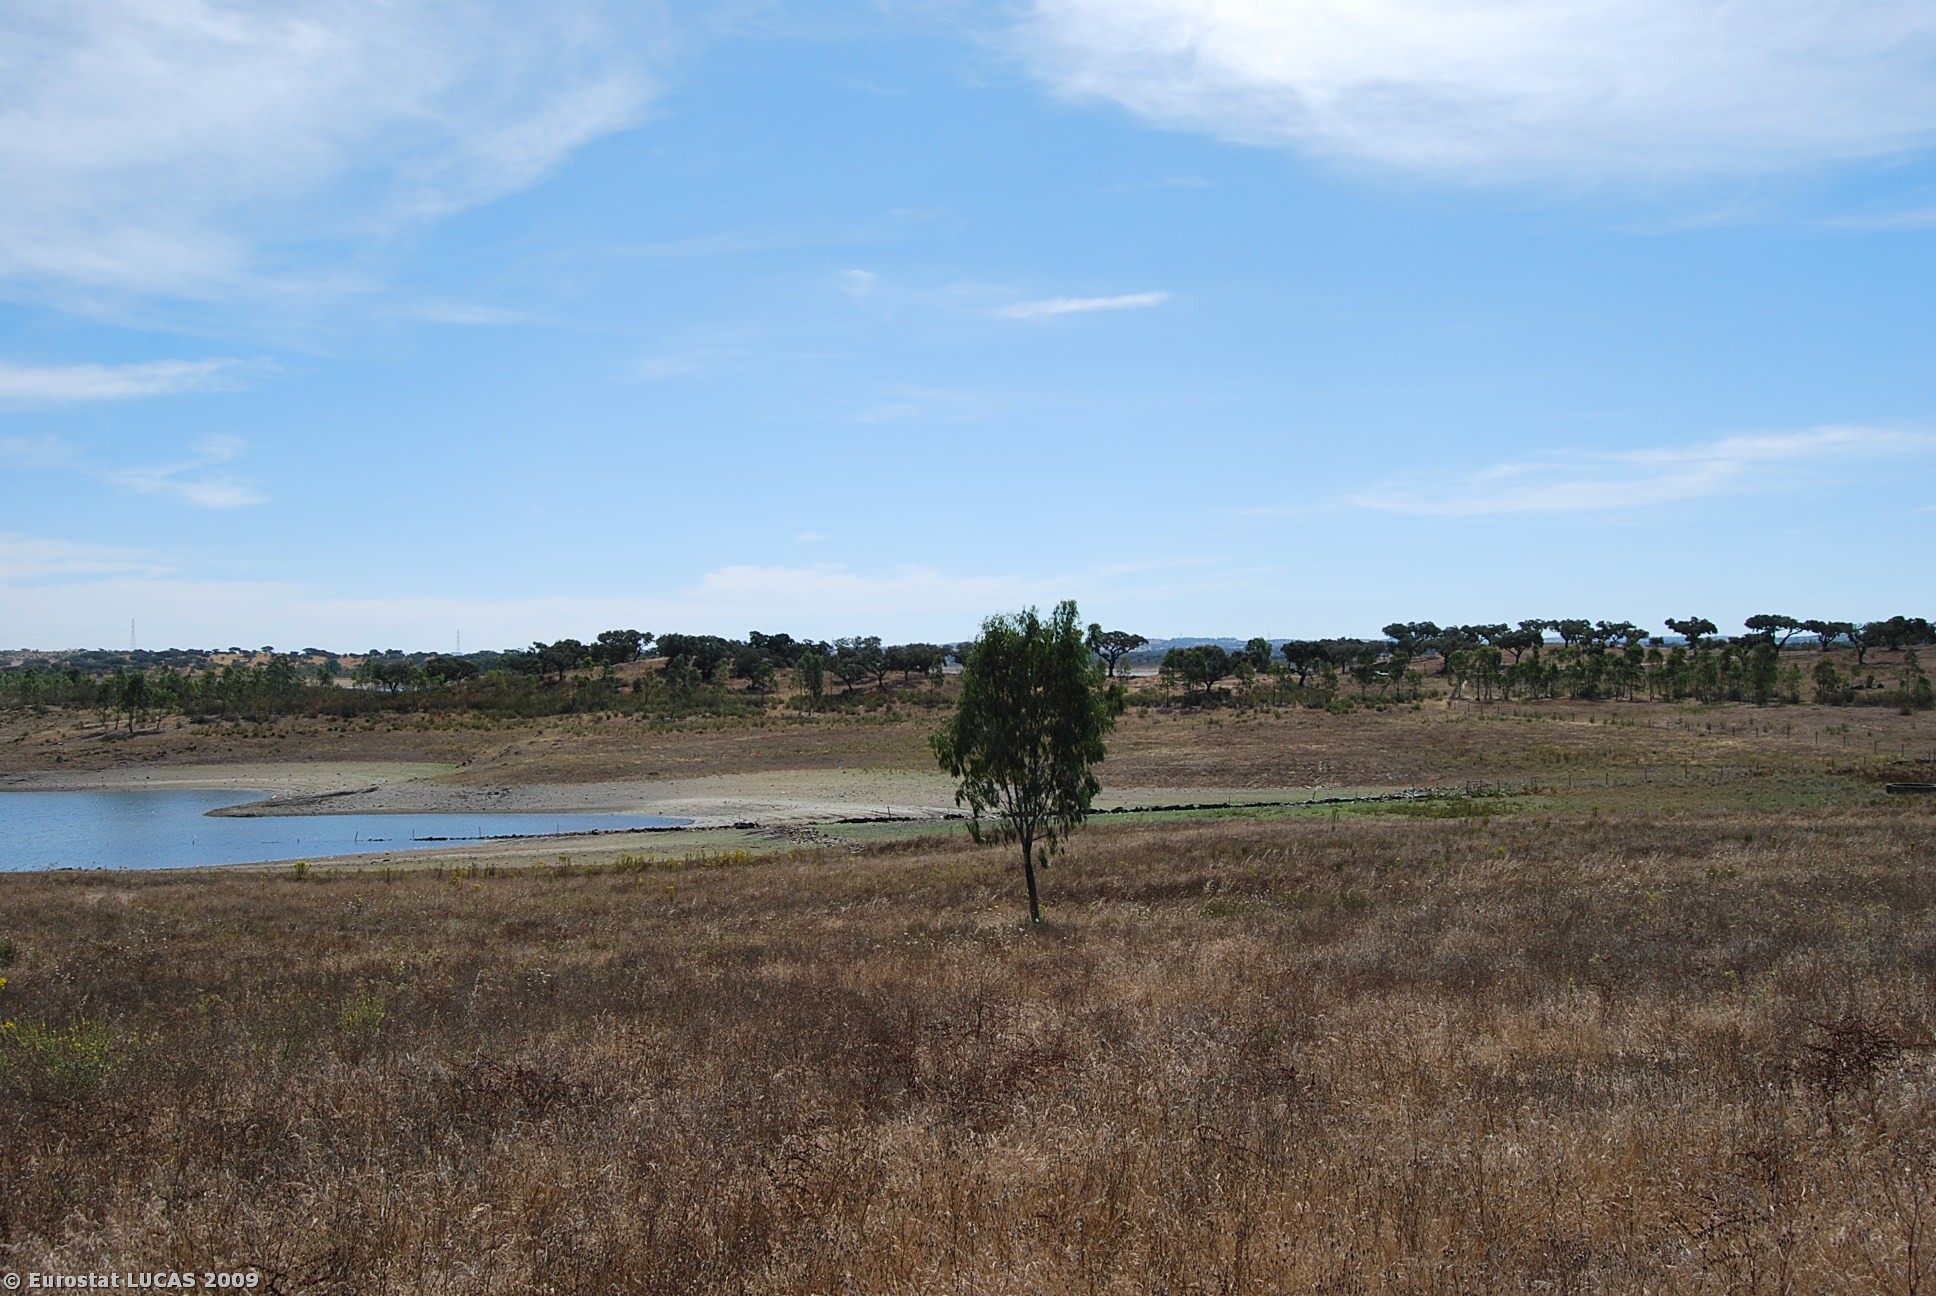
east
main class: Grassland
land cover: Grassland with sparse tree/shrub cover
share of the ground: 50 - 75 %
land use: Fallow land
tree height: > 5 m
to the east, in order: Grassland with sparse tree/shrub cover; Tracks; Spontaneously vegetated surfaces; Single bushes/trees; Spontaneously vegetated surfaces; Bare land; Fences; Dry stone walls; Bare land; Spontaneously vegetated surfaces
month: July
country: PT
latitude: 37.7180
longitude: -8.2852
